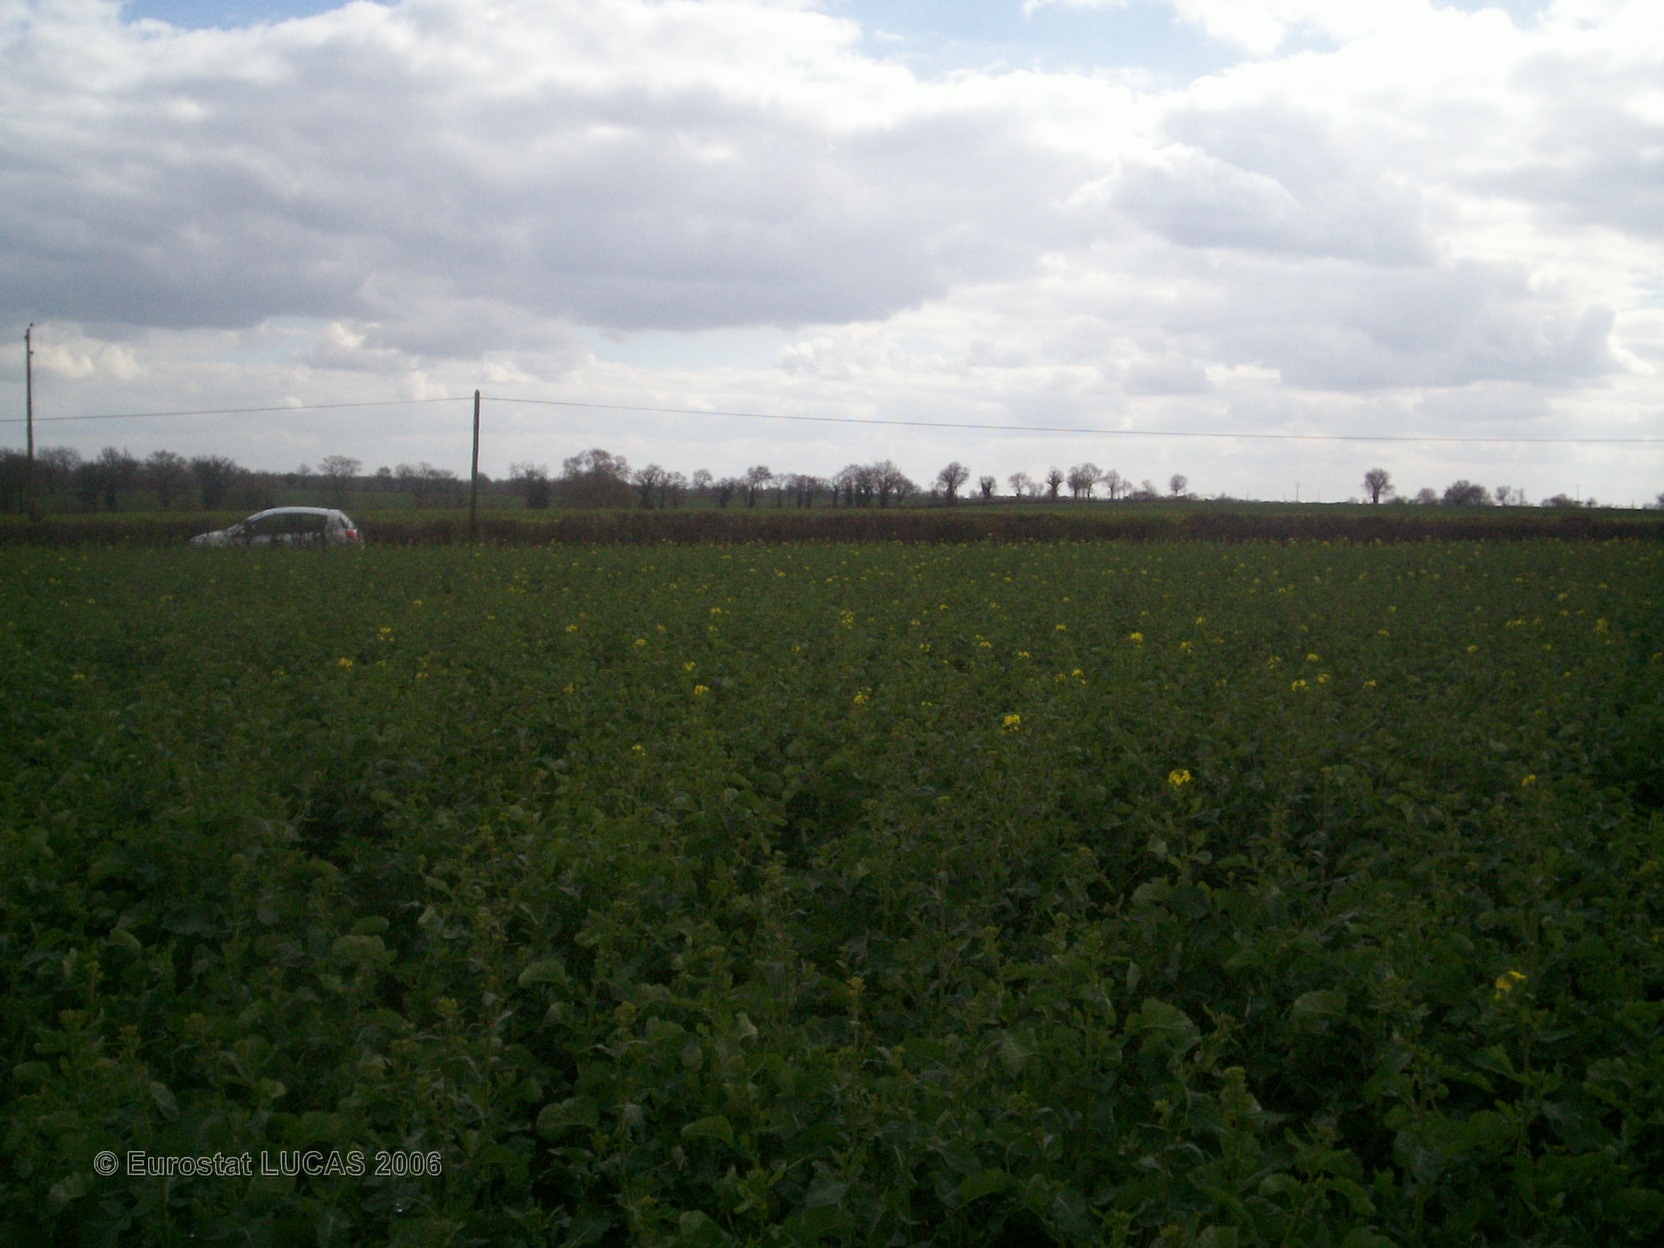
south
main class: Cropland
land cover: Rape and turnip rape
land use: Agriculture (excluding fallow land and kitchen gardens)
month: April
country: FR
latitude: 46.4124
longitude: 1.0758
